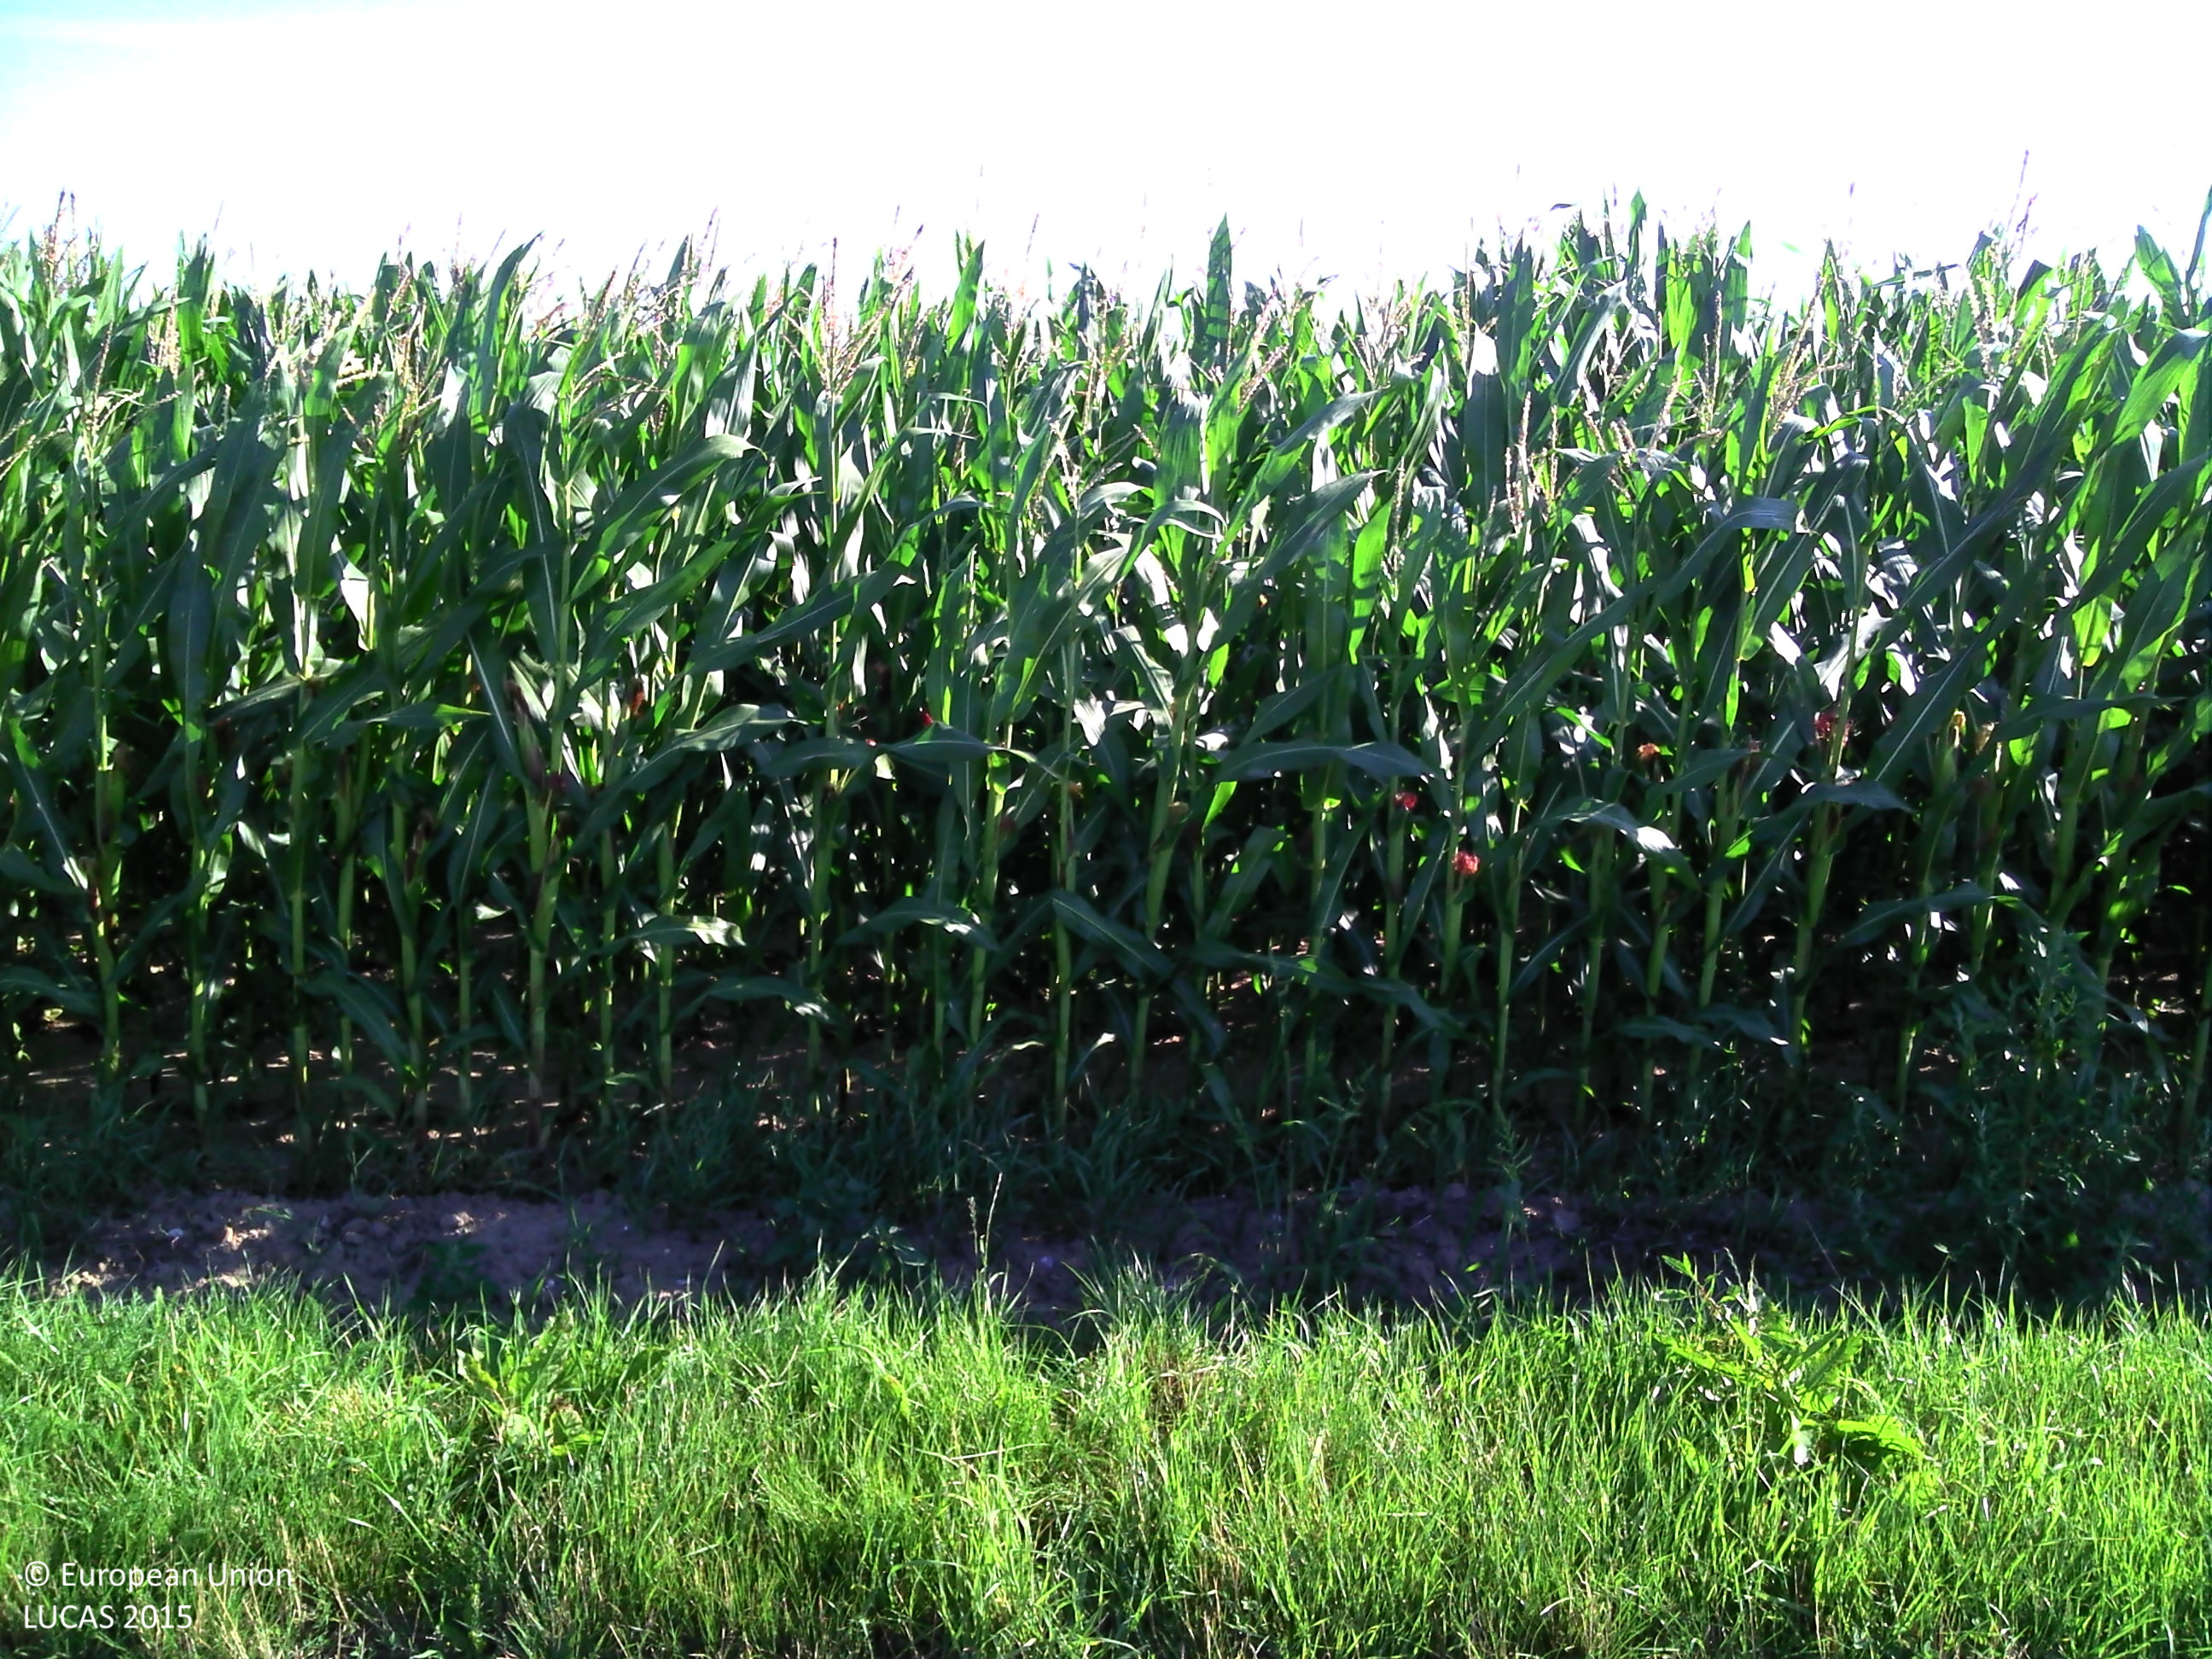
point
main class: Cropland
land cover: Maize
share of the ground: > 75 %
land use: Agriculture (excluding fallow land and kitchen gardens)
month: August
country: BE
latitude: 51.1420
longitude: 5.5530
